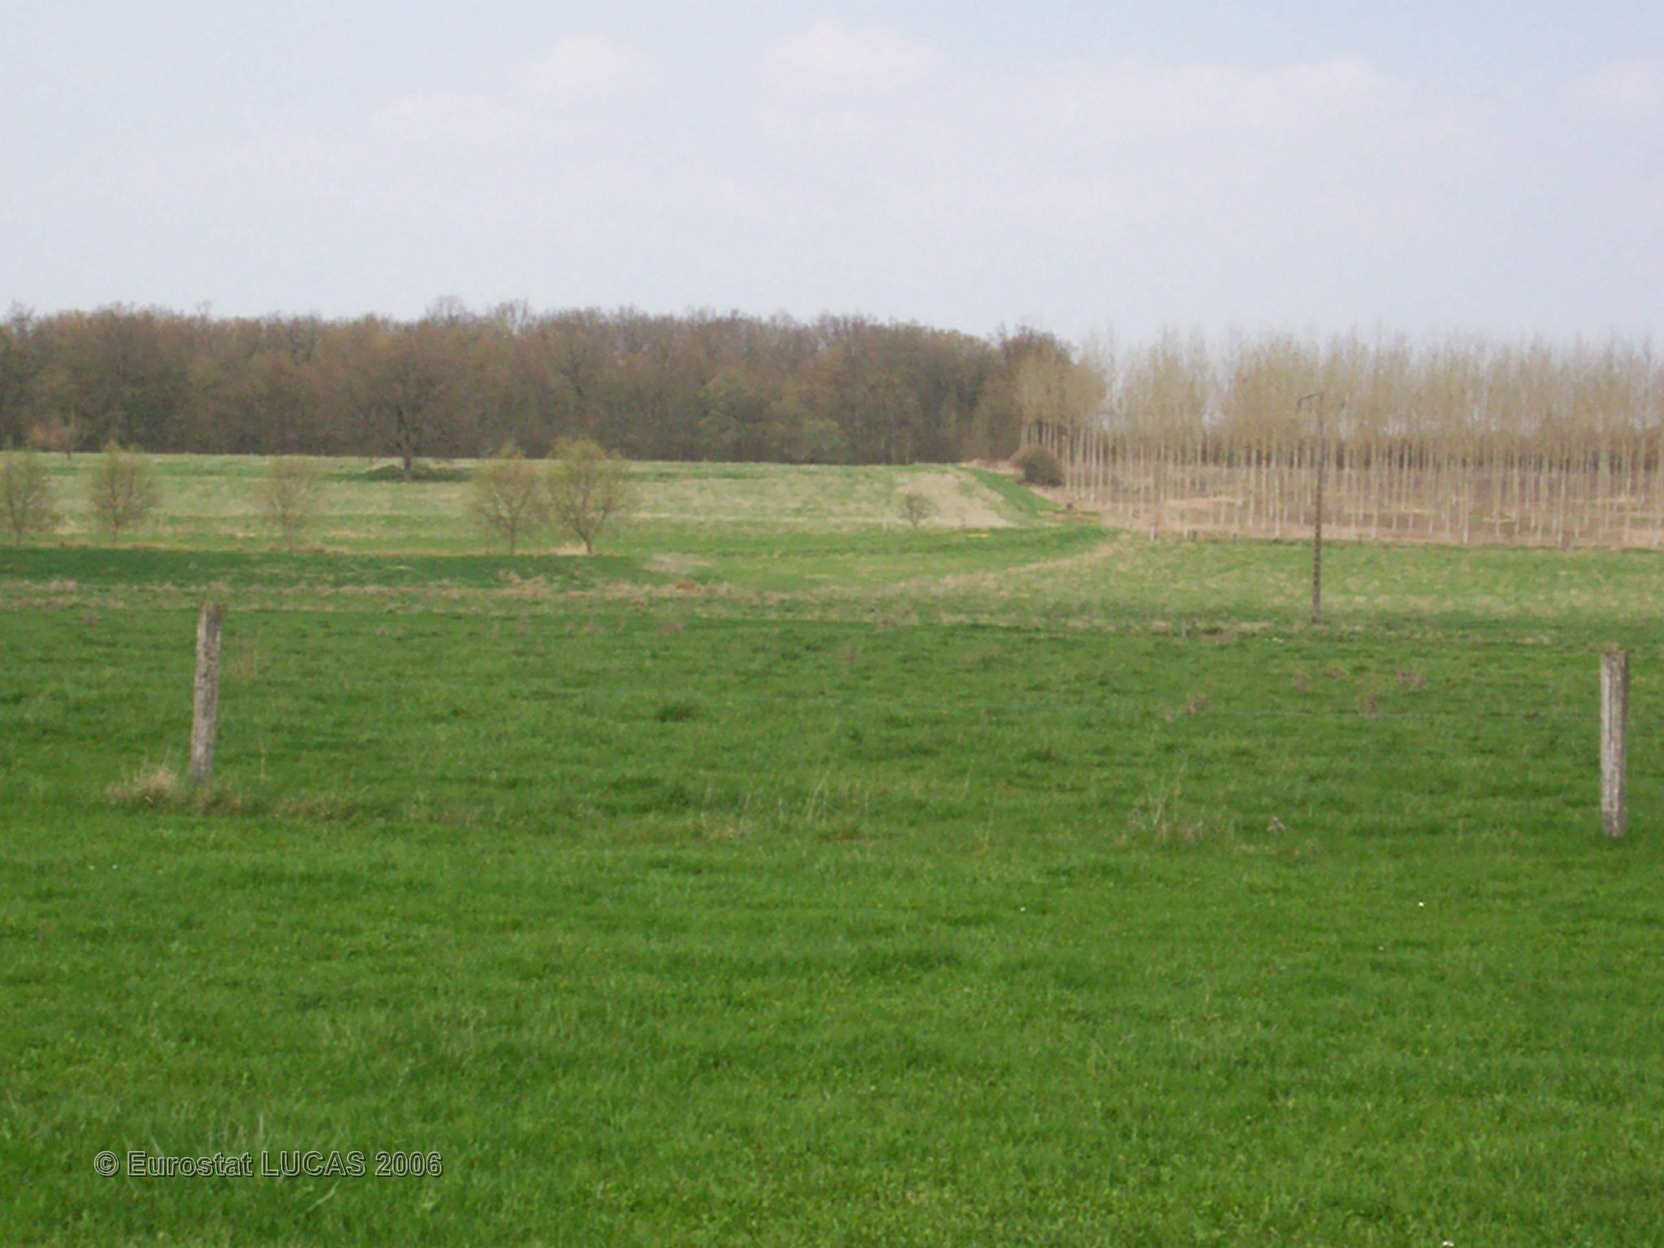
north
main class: Grassland
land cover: Grassland without tree/shrub cover
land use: Agriculture (excluding fallow land and kitchen gardens)
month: April
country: FR
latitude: 48.7780
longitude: 5.9035
